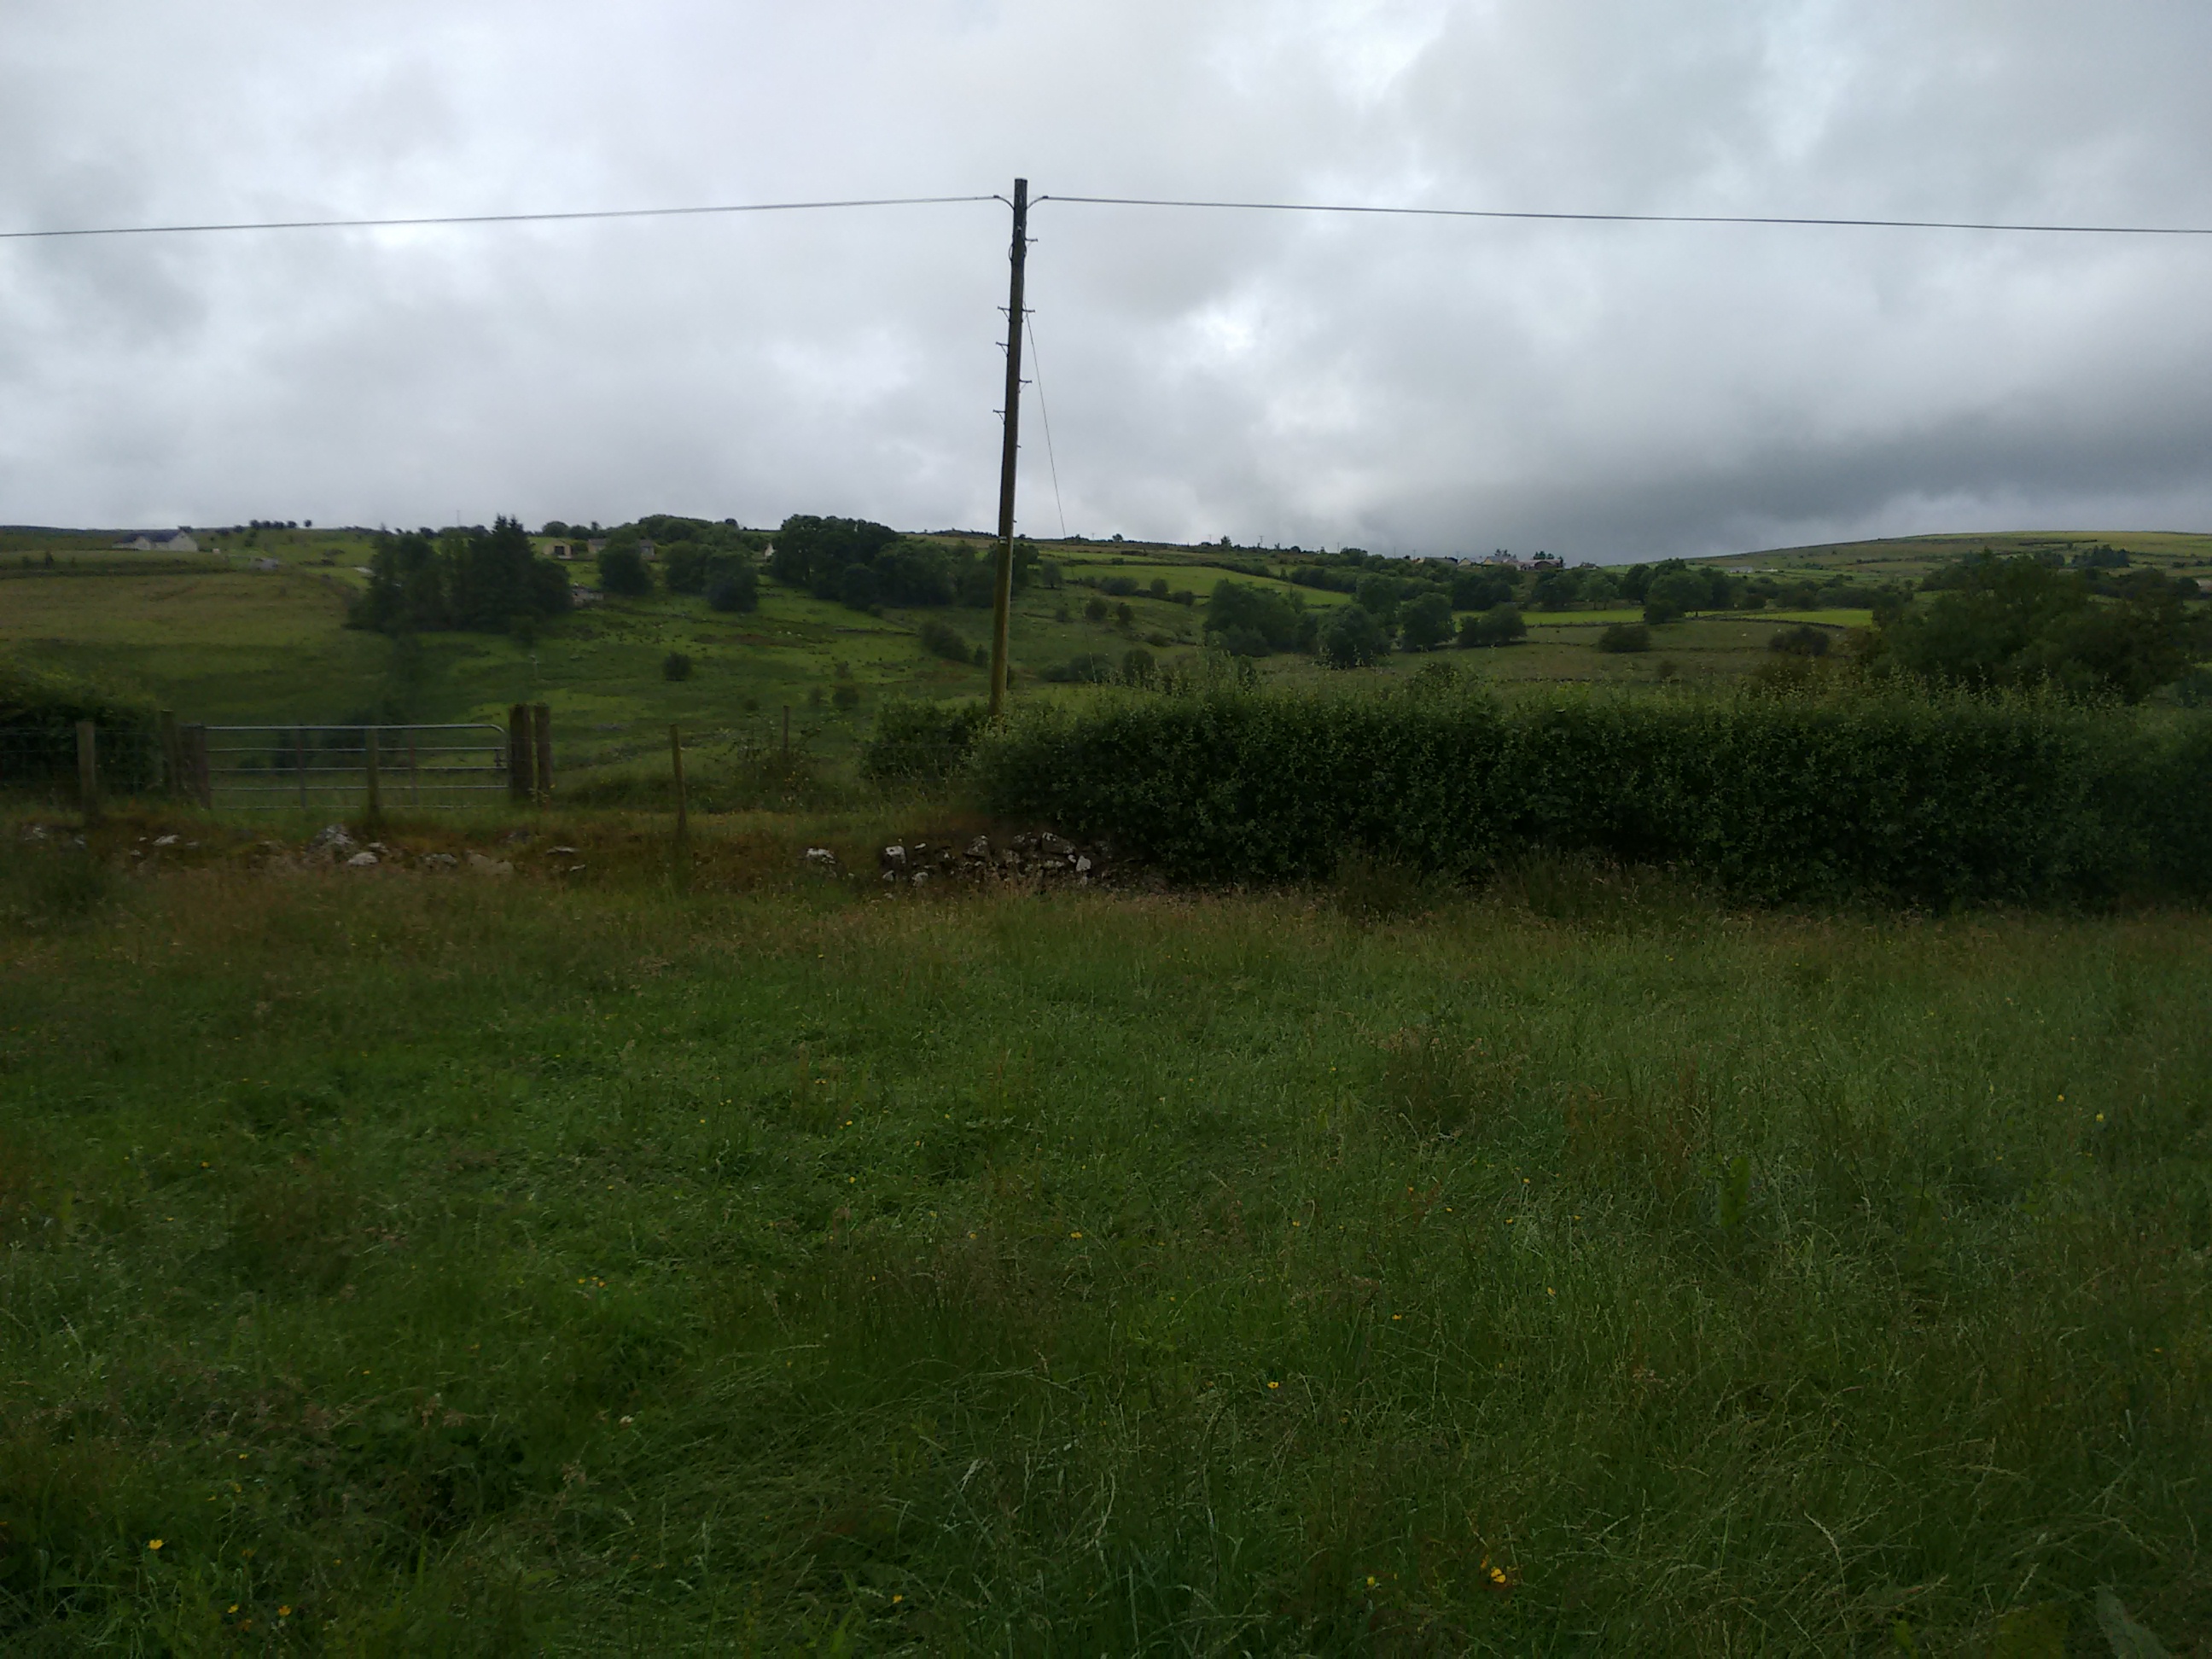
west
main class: Grassland
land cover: Grassland without tree/shrub cover
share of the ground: > 75 %
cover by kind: herbaceous plants 100 %
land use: Agriculture (excluding fallow land and kitchen gardens)
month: July
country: GB
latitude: 54.7033
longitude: -7.0399
